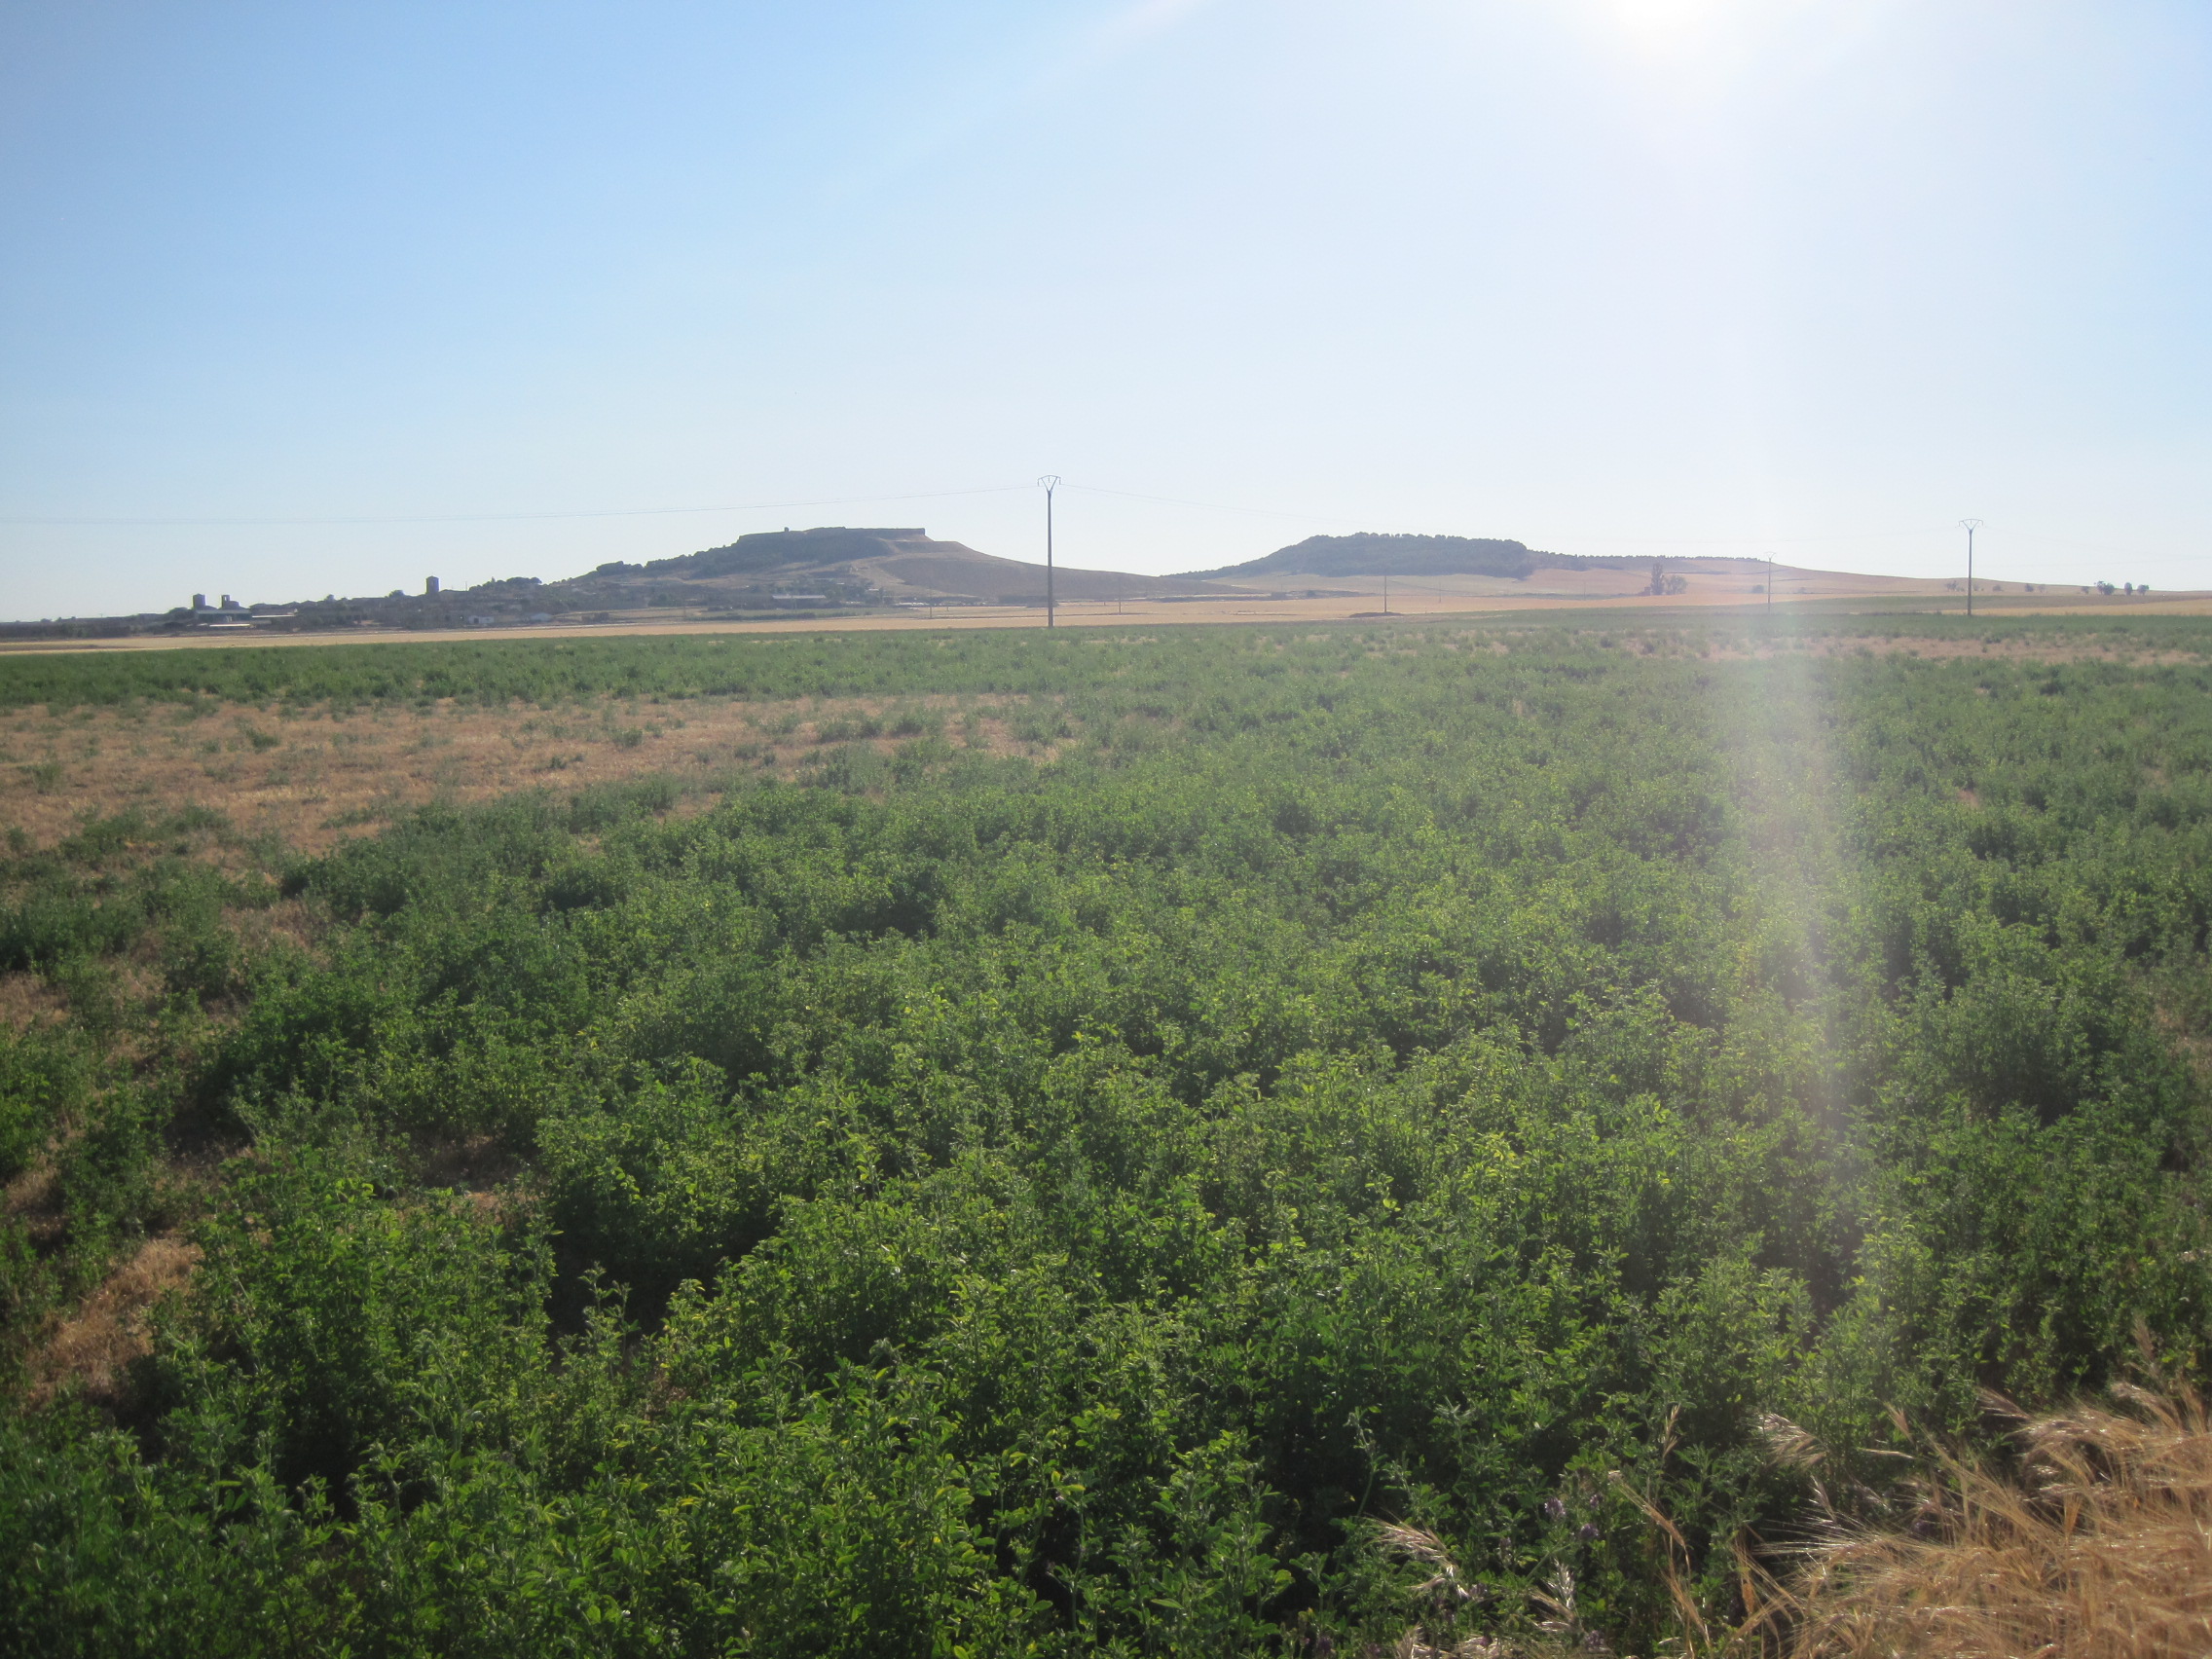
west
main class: Cropland
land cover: Barley
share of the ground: > 75 %
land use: Agriculture (excluding fallow land and kitchen gardens)
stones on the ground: 10 - 25 %
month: June
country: ES
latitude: 41.8203
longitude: -5.1395
